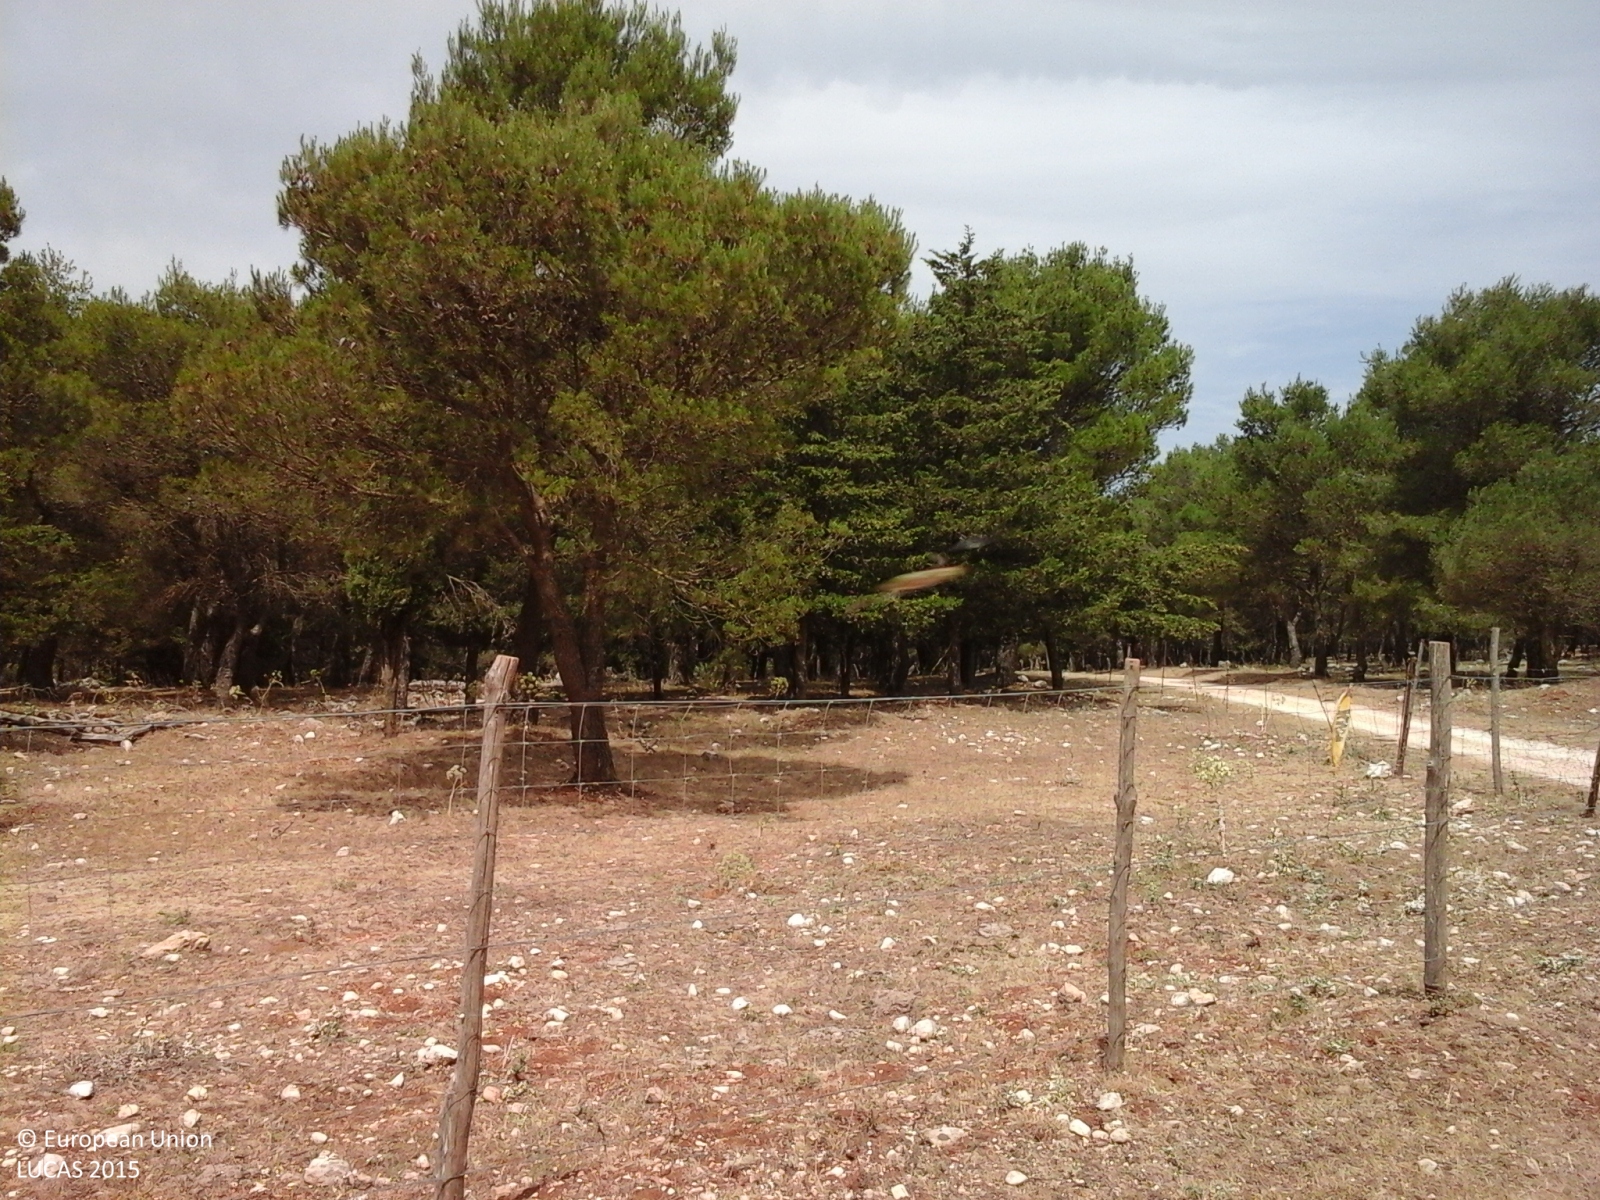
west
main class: Woodland
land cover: Pine dominated coniferous woodland
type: coniferous forest of the mediterranean region
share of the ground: > 75 %
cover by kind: coniferous forest trees 100 %
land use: Forestry
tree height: > 5 m
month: June
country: IT
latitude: 37.6231
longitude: 13.1374
